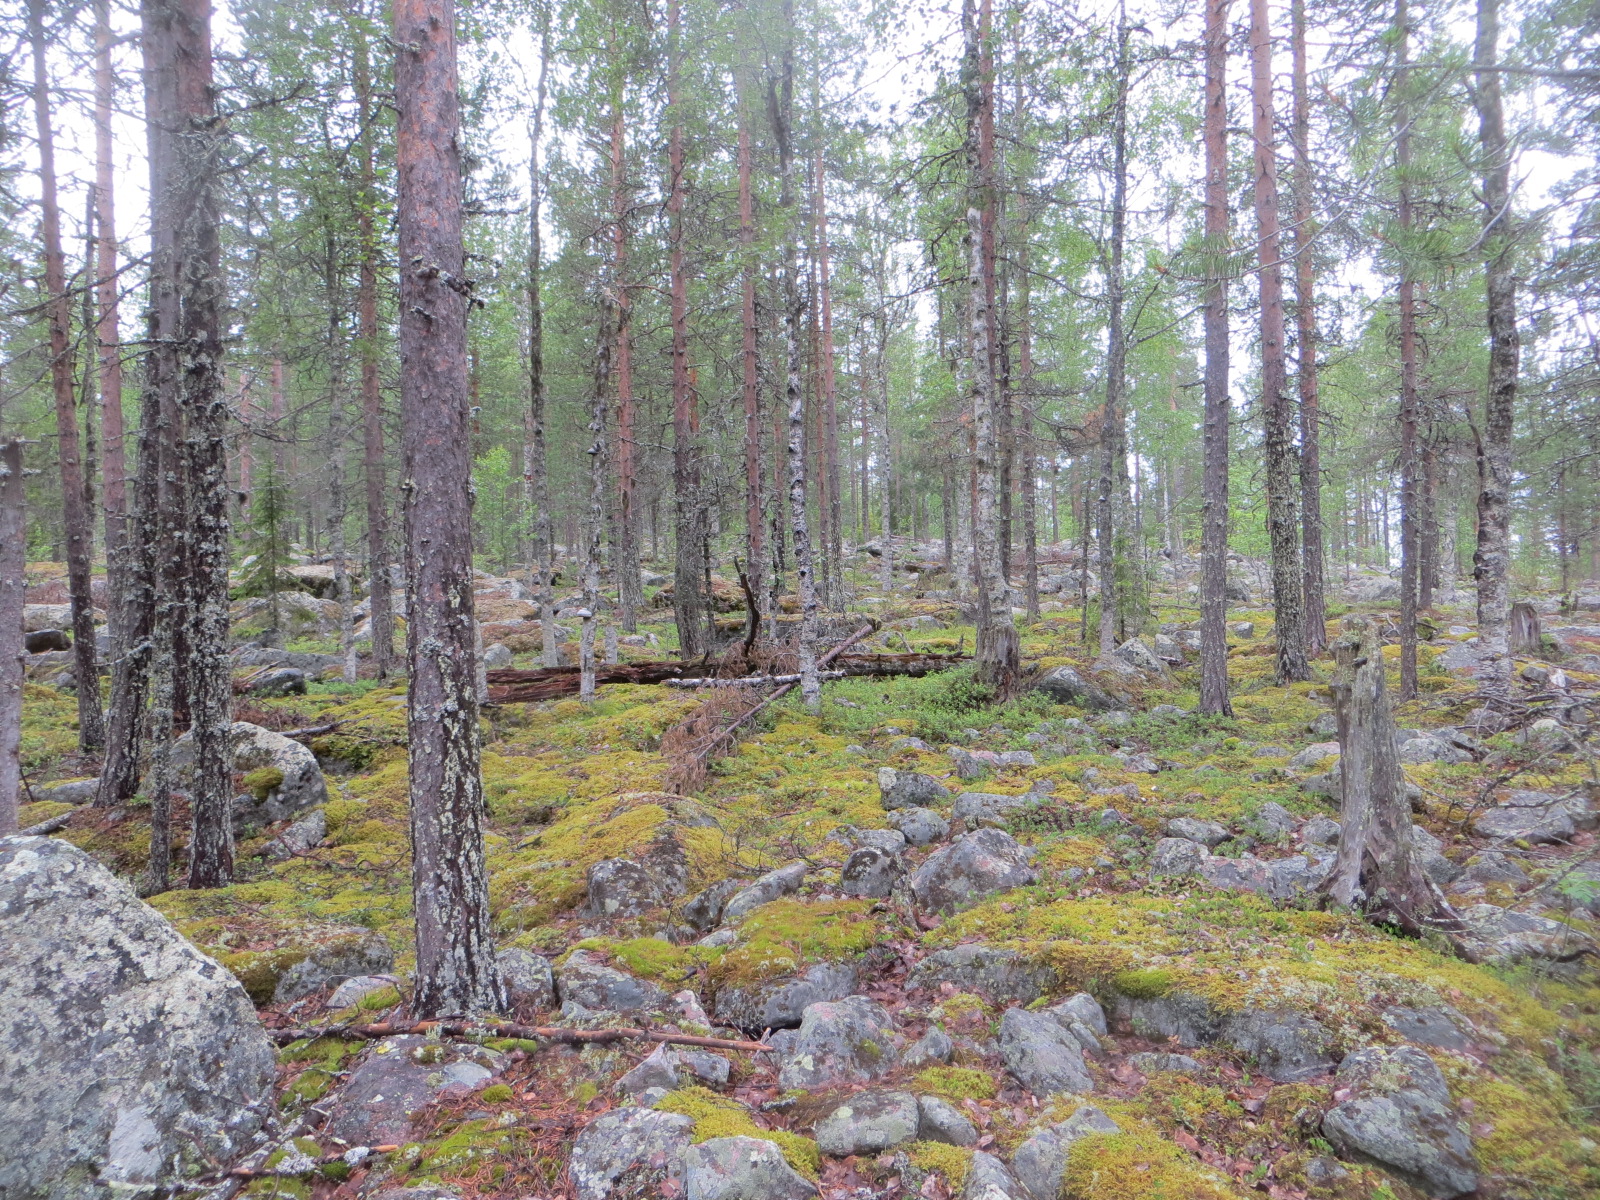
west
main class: Woodland
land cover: Pine dominated mixed woodland
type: boreal forest
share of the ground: 50 - 75 %
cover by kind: coniferous forest trees 40 %, broadleaved forest trees 30 %, shrubs 20 %, unconsolidated bare surface 10 %
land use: Forestry
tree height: > 5 m
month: July
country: FI
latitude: 66.5139
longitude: 24.5033
